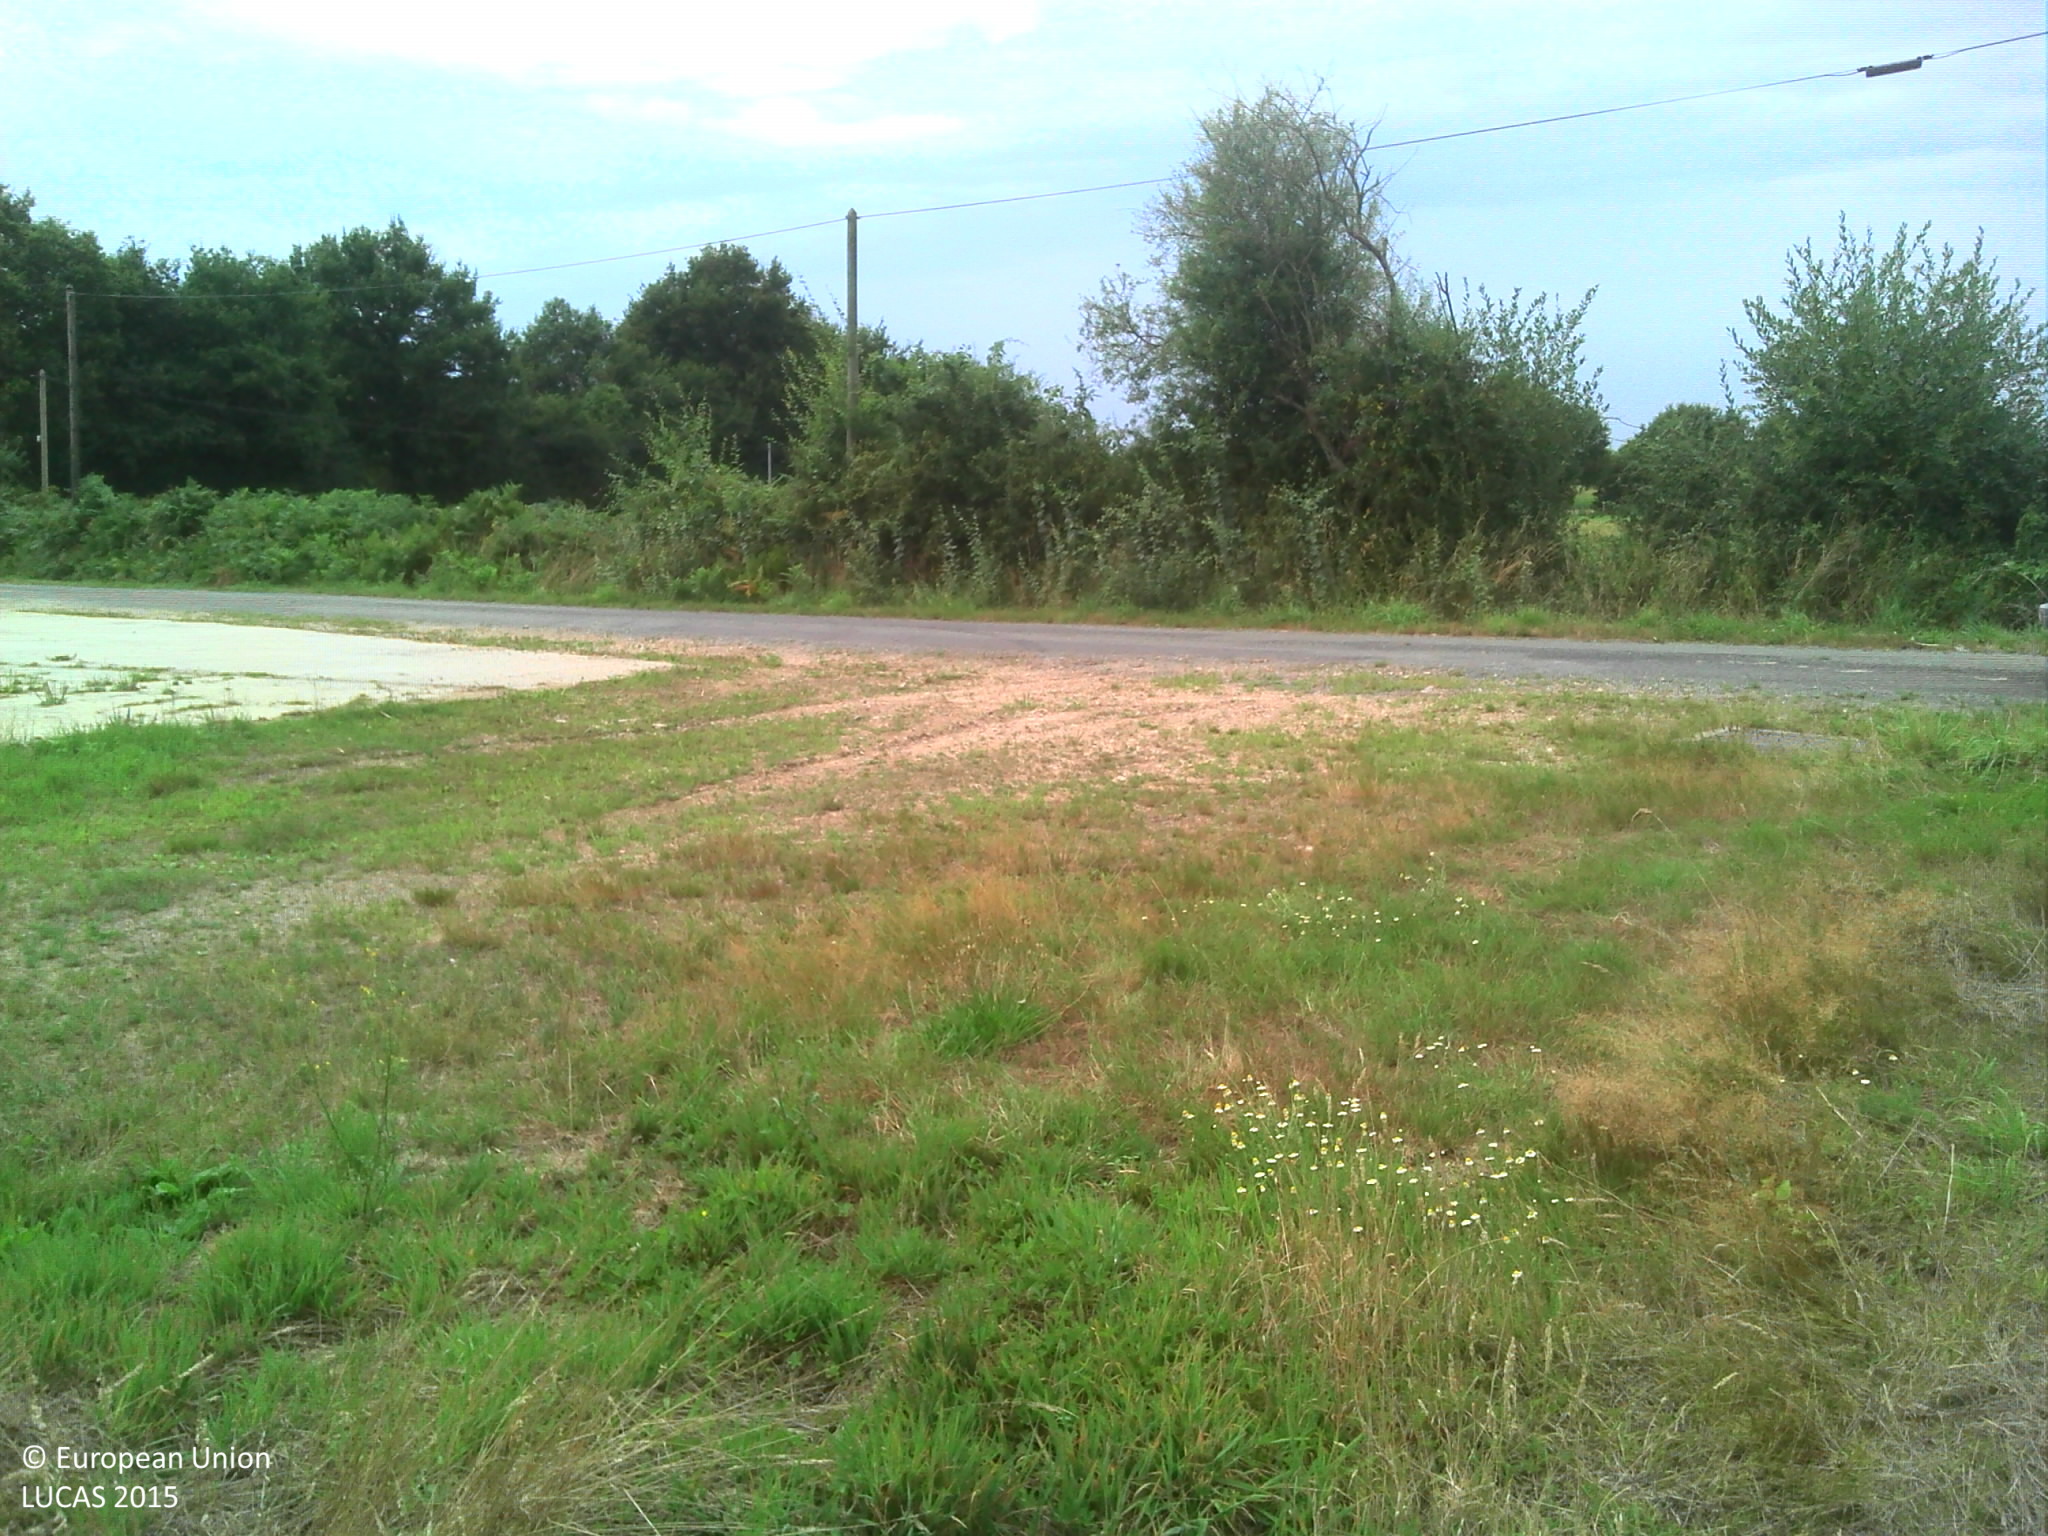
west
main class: Grassland
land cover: Grassland without tree/shrub cover
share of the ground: > 75 %
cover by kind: herbaceous plants 100 %
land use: Agriculture (excluding fallow land and kitchen gardens)
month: August
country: FR
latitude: 46.6571
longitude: -1.6580
